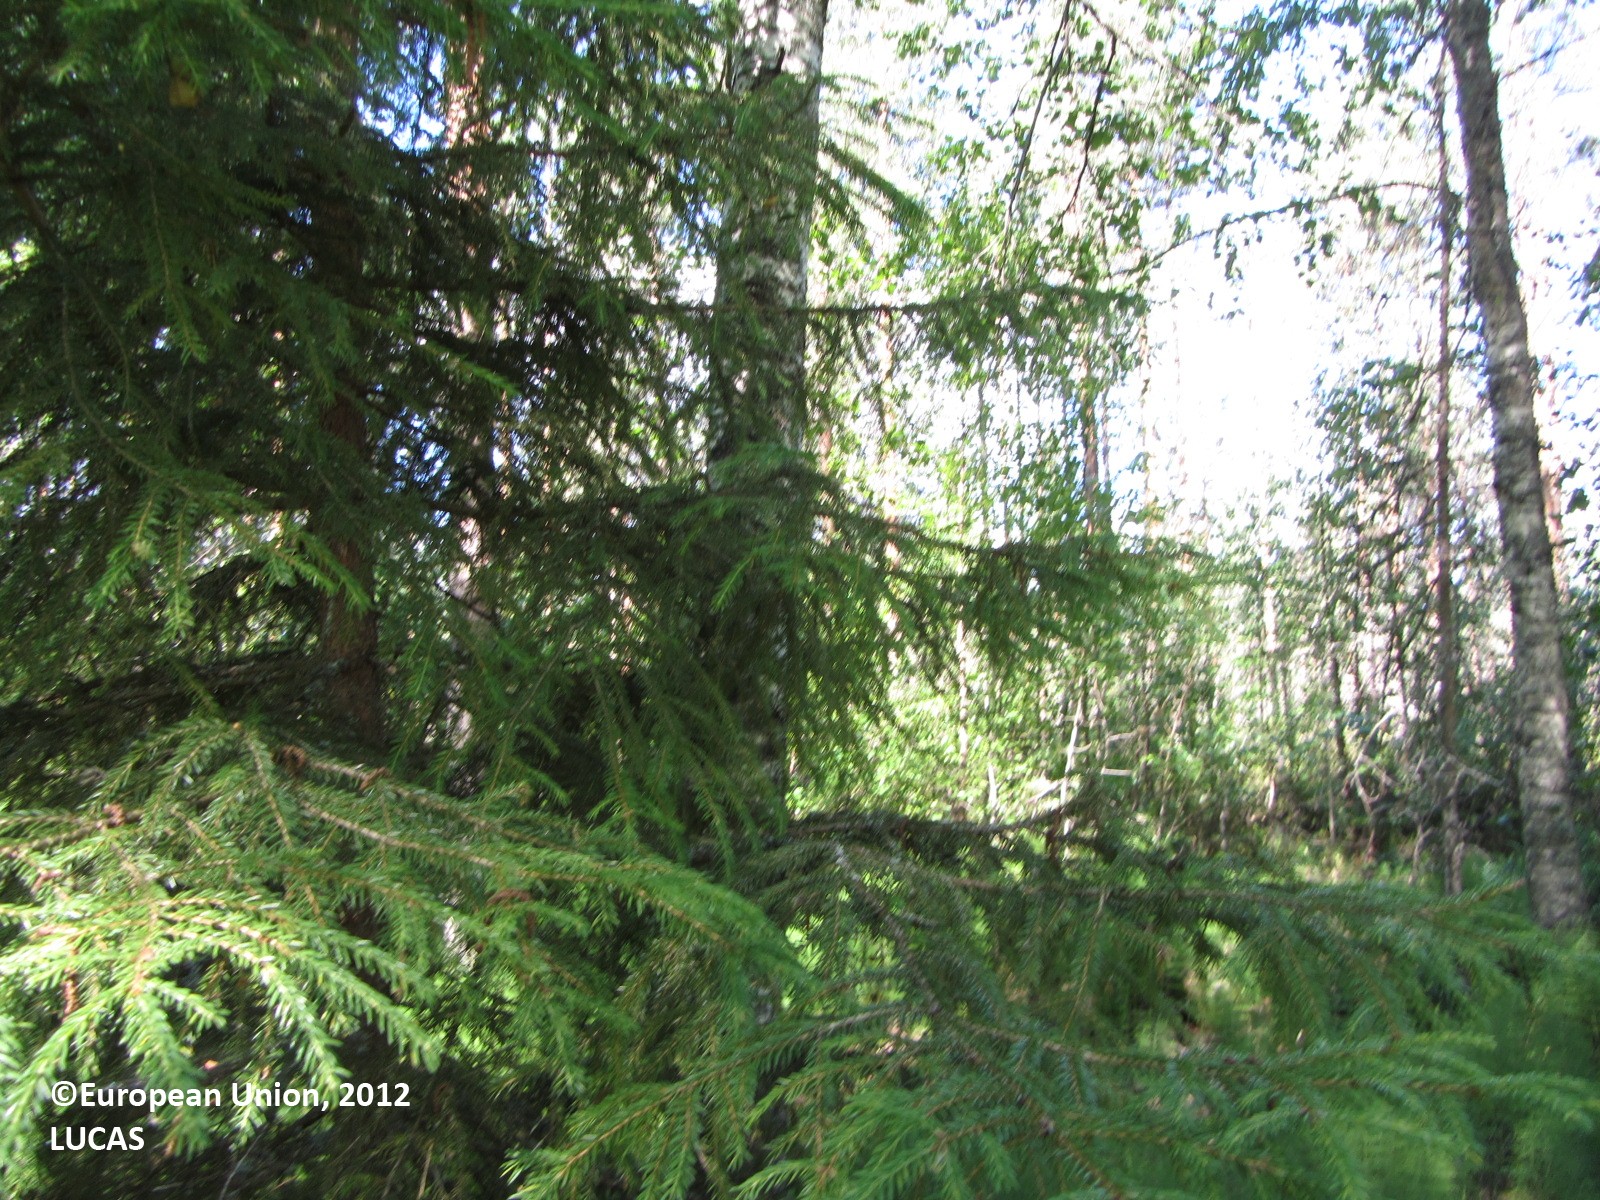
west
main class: Woodland
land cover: Other mixed woodland
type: boreal forest
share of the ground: > 75 %
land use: Forestry
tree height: > 5 m
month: July
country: FI
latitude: 63.1004
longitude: 25.2560
